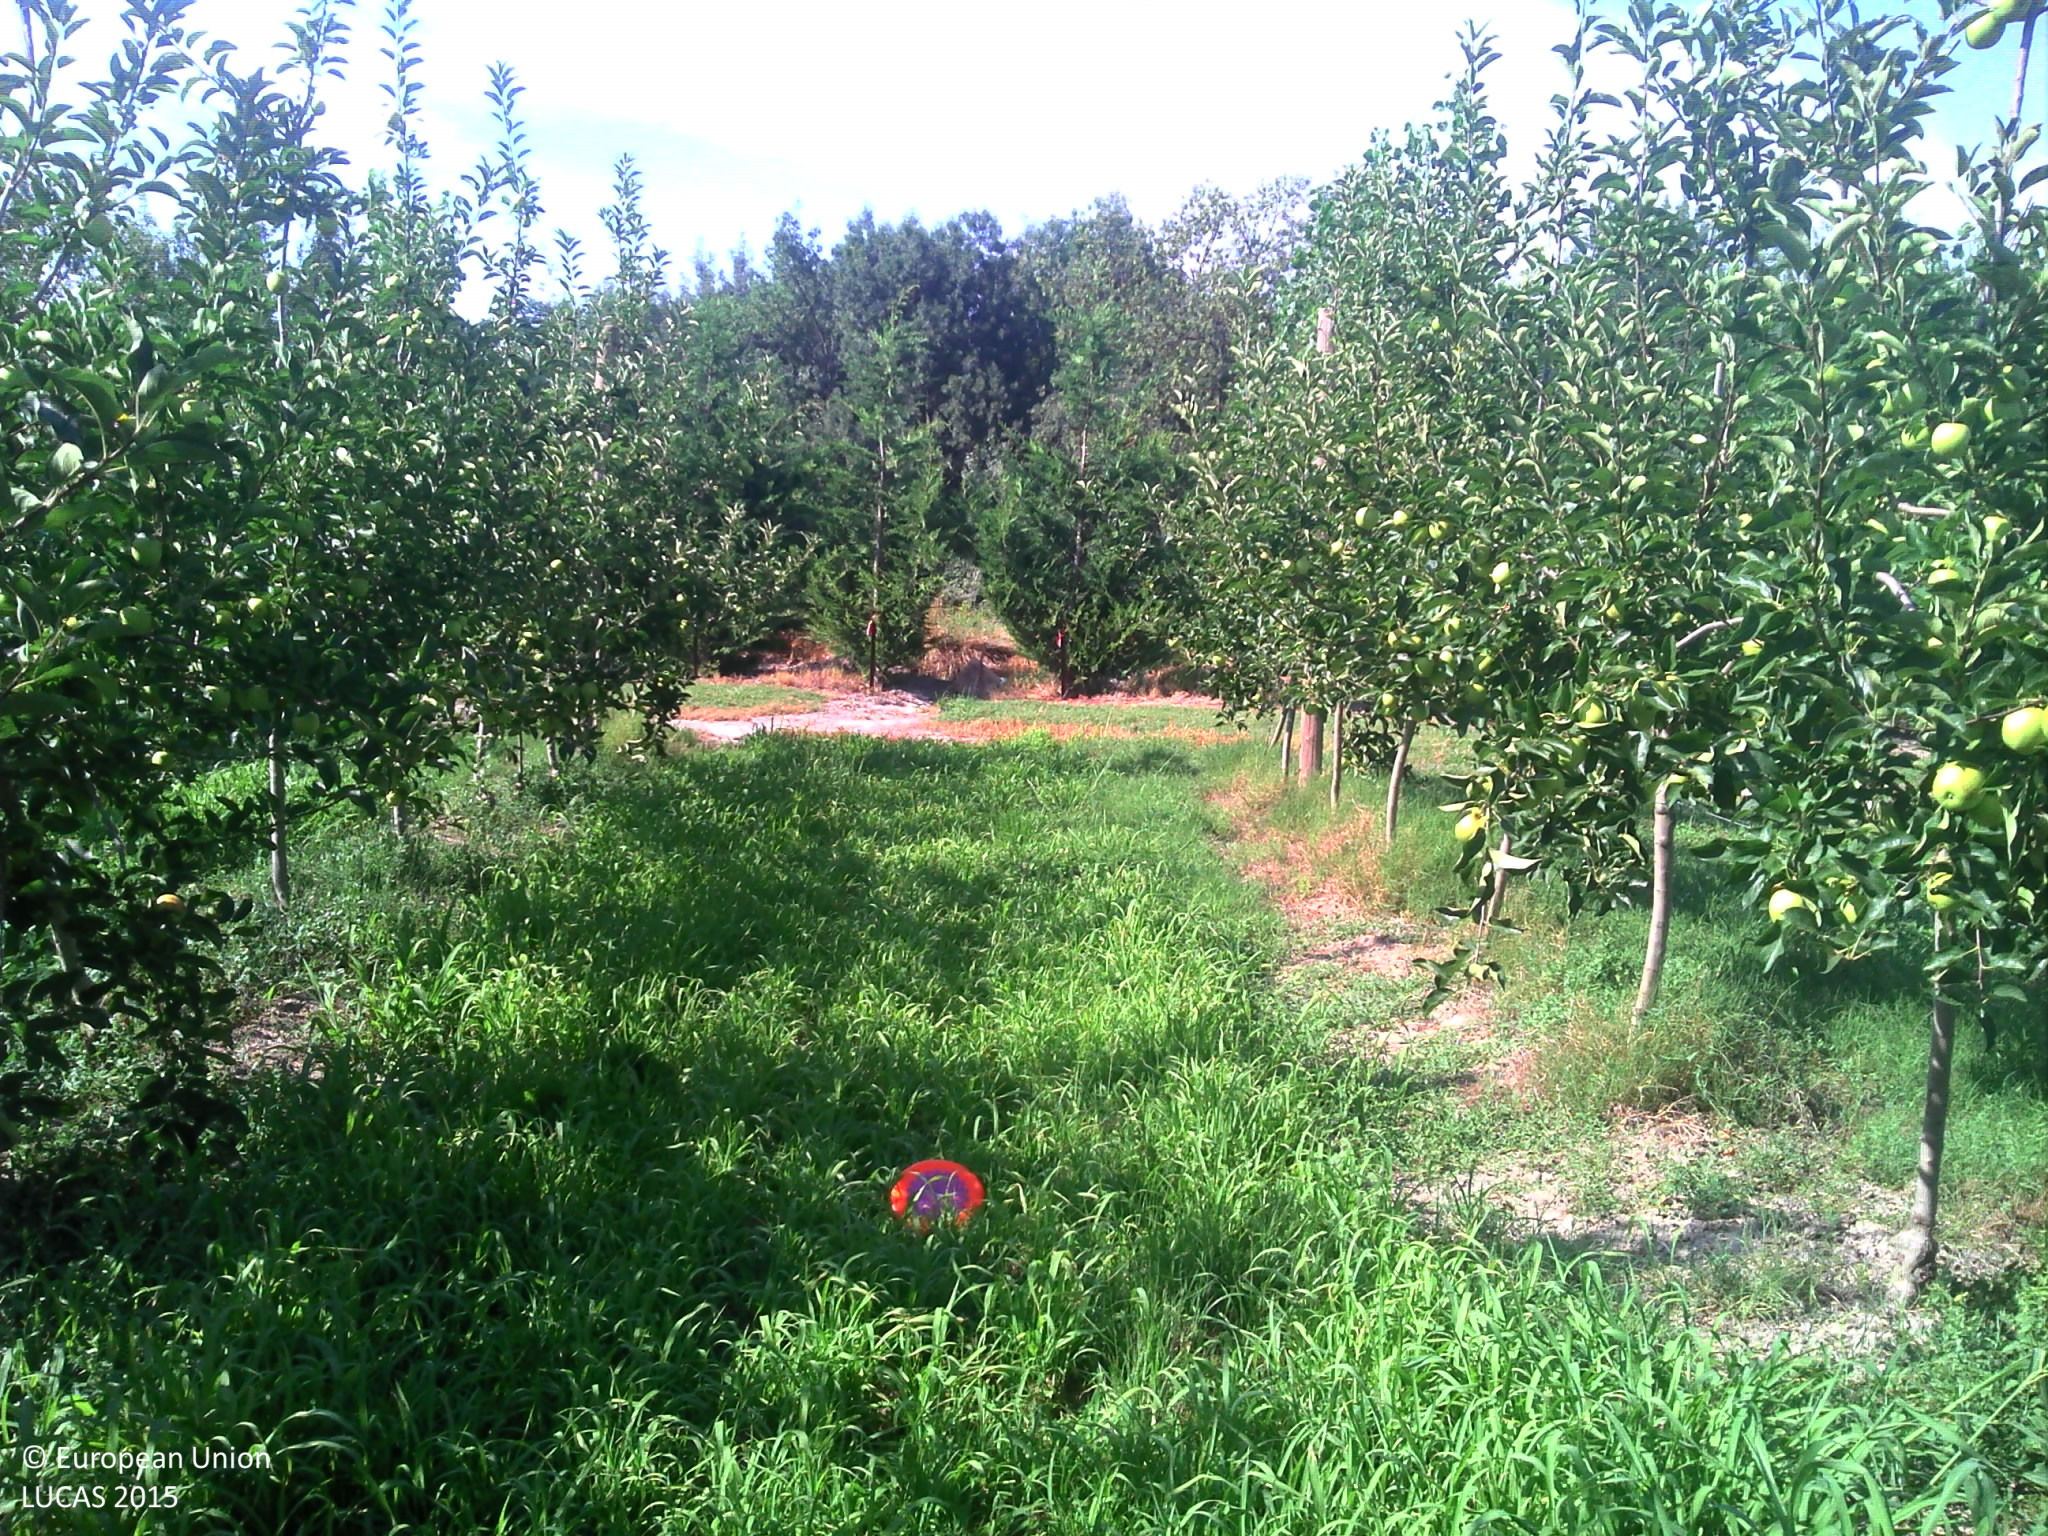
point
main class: Cropland
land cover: Apple fruit
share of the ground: 50 - 75 %
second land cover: Grassland without tree/shrub cover
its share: 25 - 50 %
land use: Agriculture (excluding fallow land and kitchen gardens)
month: July
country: FR
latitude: 43.8008
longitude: 4.7265
